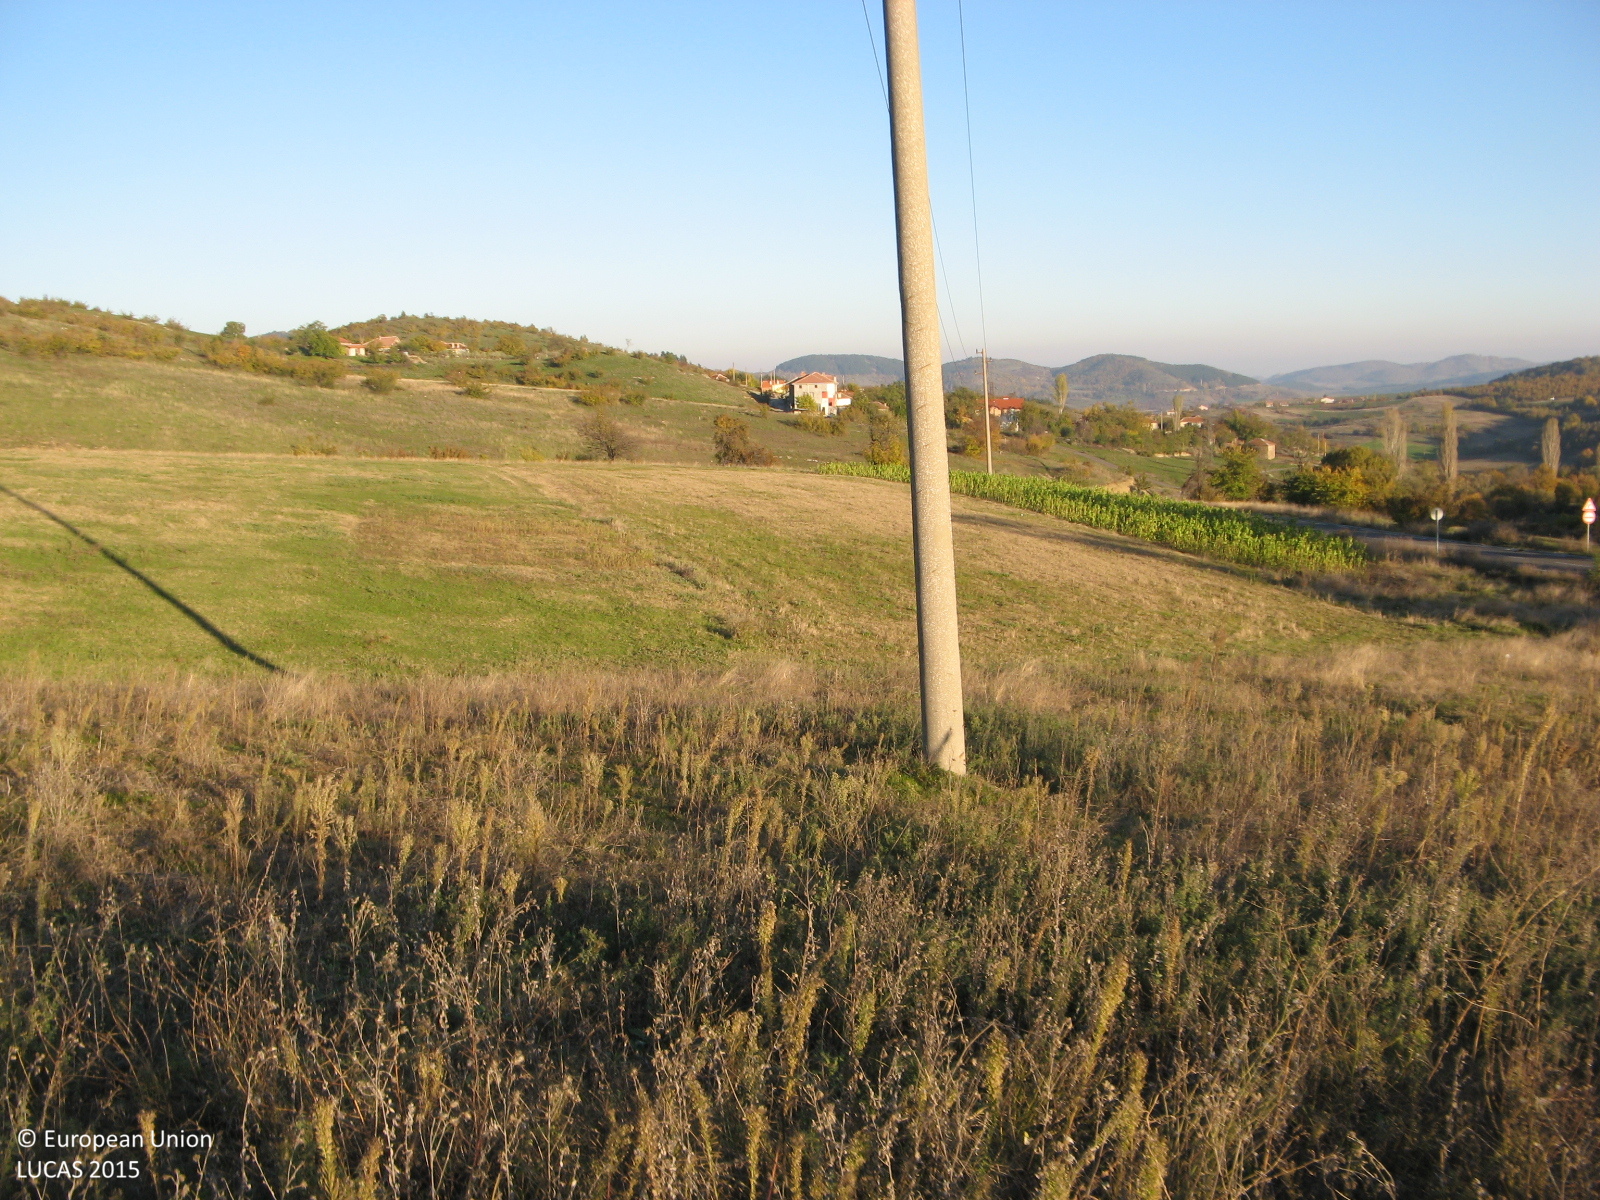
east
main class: Grassland
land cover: Spontaneously vegetated surfaces
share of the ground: > 75 %
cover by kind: herbaceous plants 100 %
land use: Fallow land
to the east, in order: Spontaneously vegetated surfaces; Electric lines; Spontaneously vegetated surfaces; Grassland without tree/shrub cover; Tracks; Grassland without tree/shrub cover; Grassland with sparse tree/shrub cover; Grassland without tree/shrub cover; Shrubland without tree cover; Grassland without tree/shrub cover; Rocks and stones; Grassland without tree/shrub cover
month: November
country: BG
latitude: 41.7559
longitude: 25.3195
